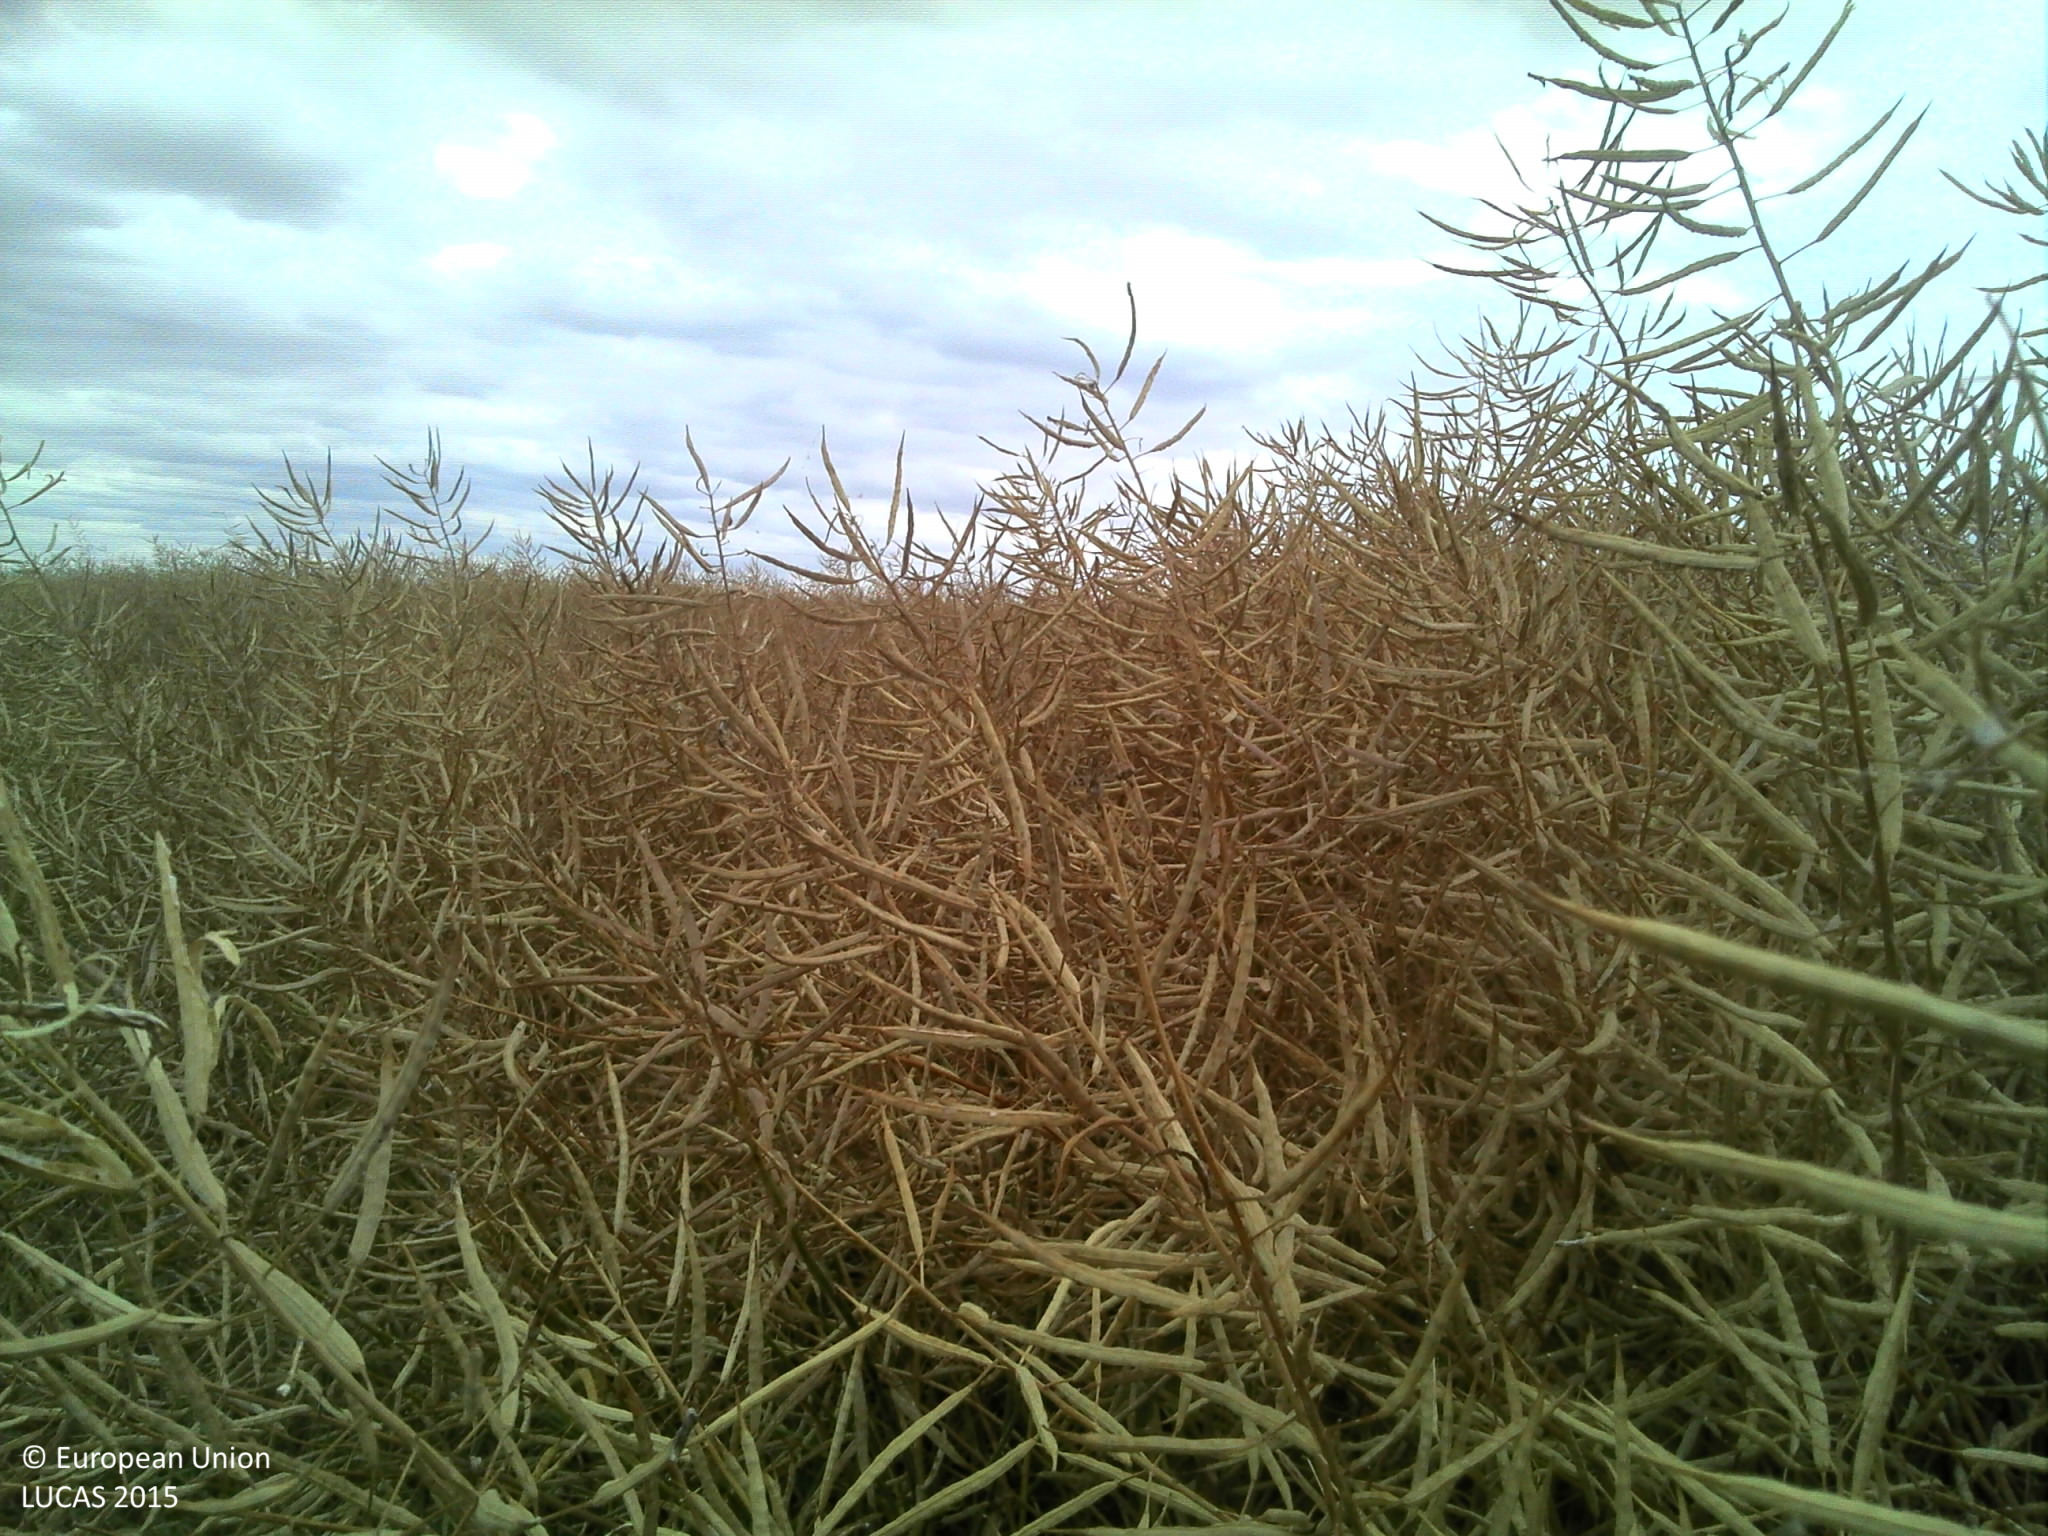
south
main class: Cropland
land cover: Rape and turnip rape
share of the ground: > 75 %
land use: Agriculture (excluding fallow land and kitchen gardens)
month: July
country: FR
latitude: 48.3504
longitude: 3.3952
